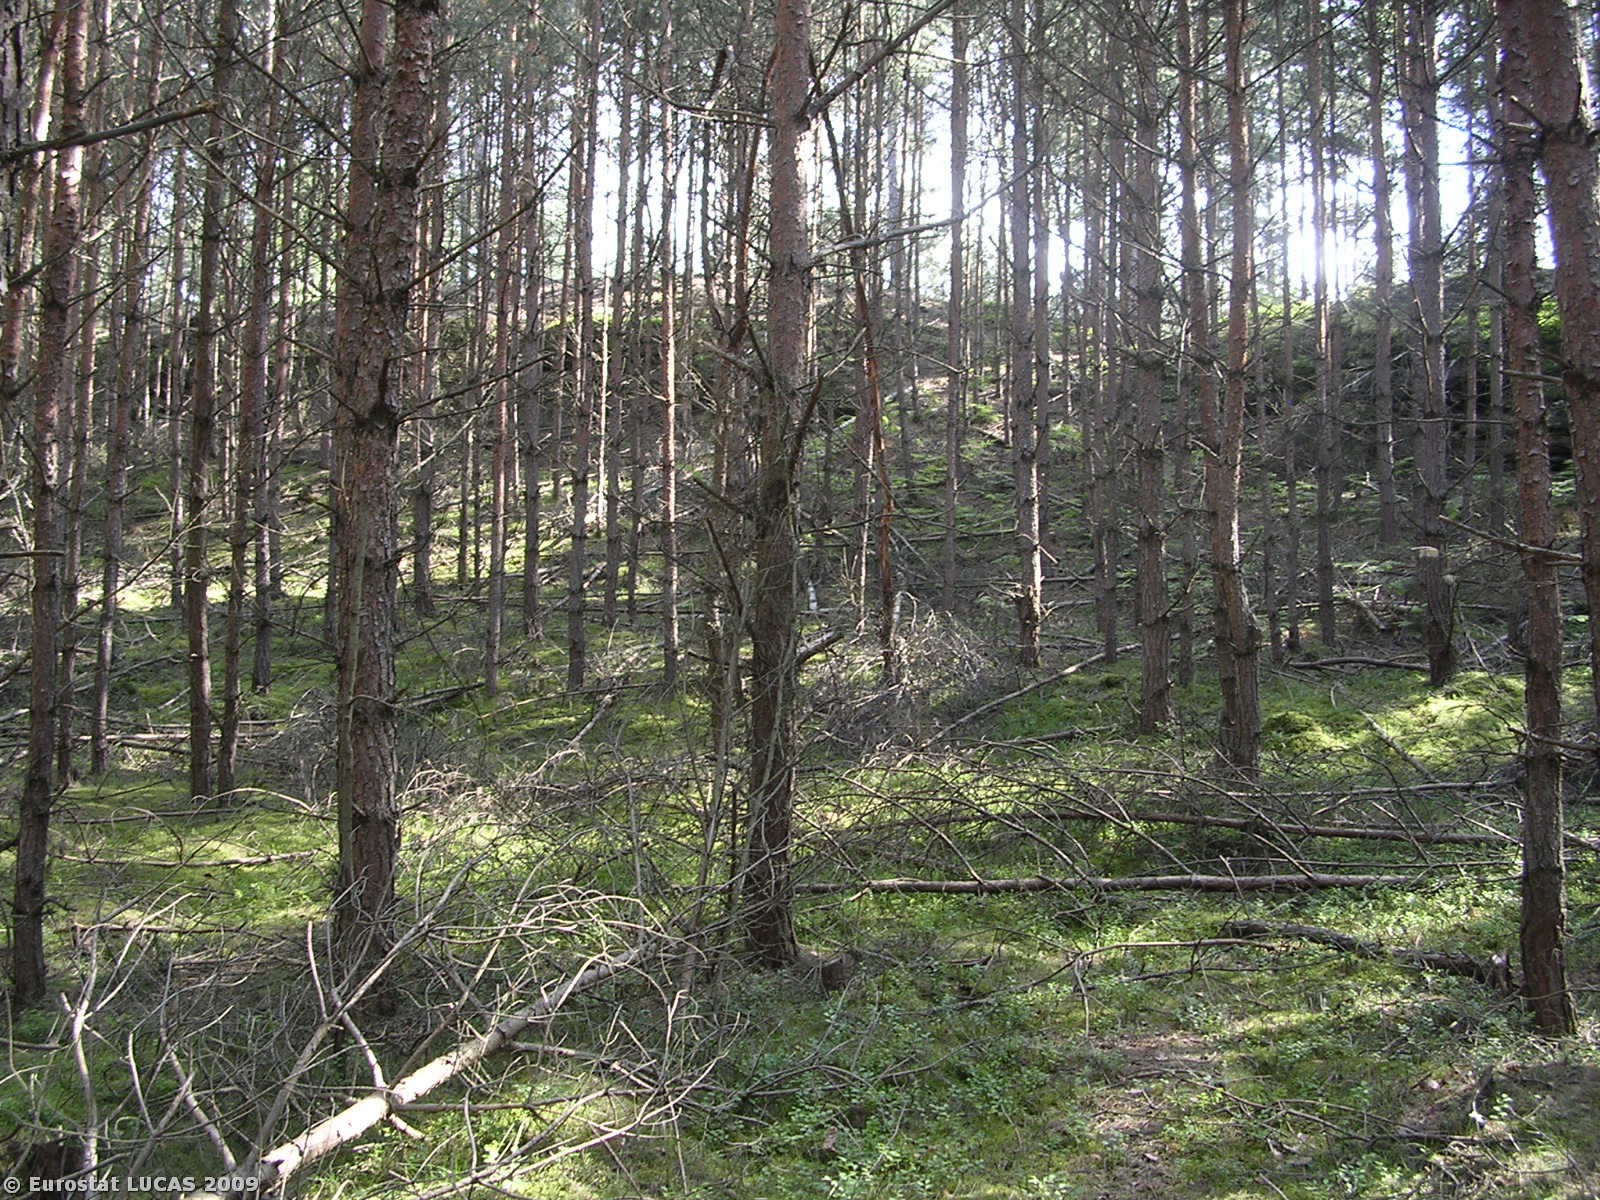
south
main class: Woodland
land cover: Coniferous woodland
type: hemiboreal forest and nemoral coniferous forest and mixed broadleaved-coniferous forest
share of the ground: > 75 %
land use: Forestry
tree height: > 5 m
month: June
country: CZ
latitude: 50.6296
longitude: 14.6532
